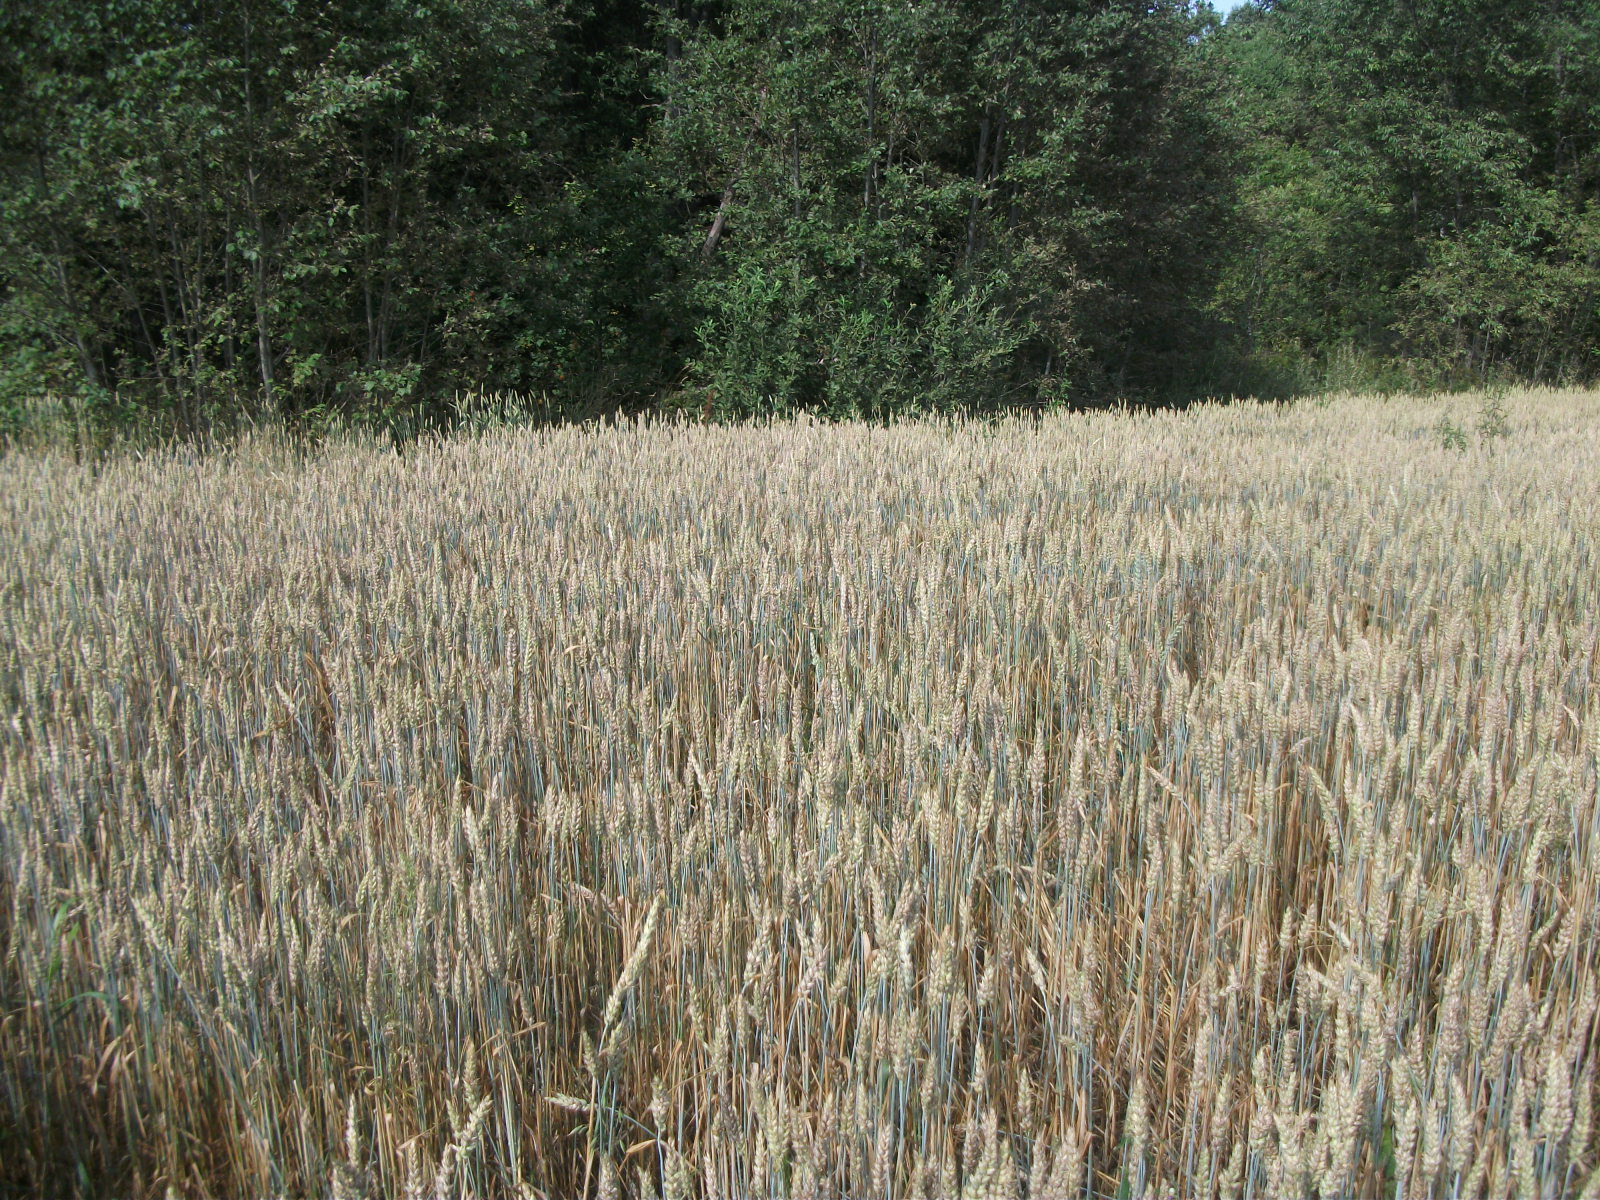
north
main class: Cropland
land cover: Common wheat
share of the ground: > 75 %
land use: Agriculture (excluding fallow land and kitchen gardens)
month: August
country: LV
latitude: 56.8348
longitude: 26.3854
